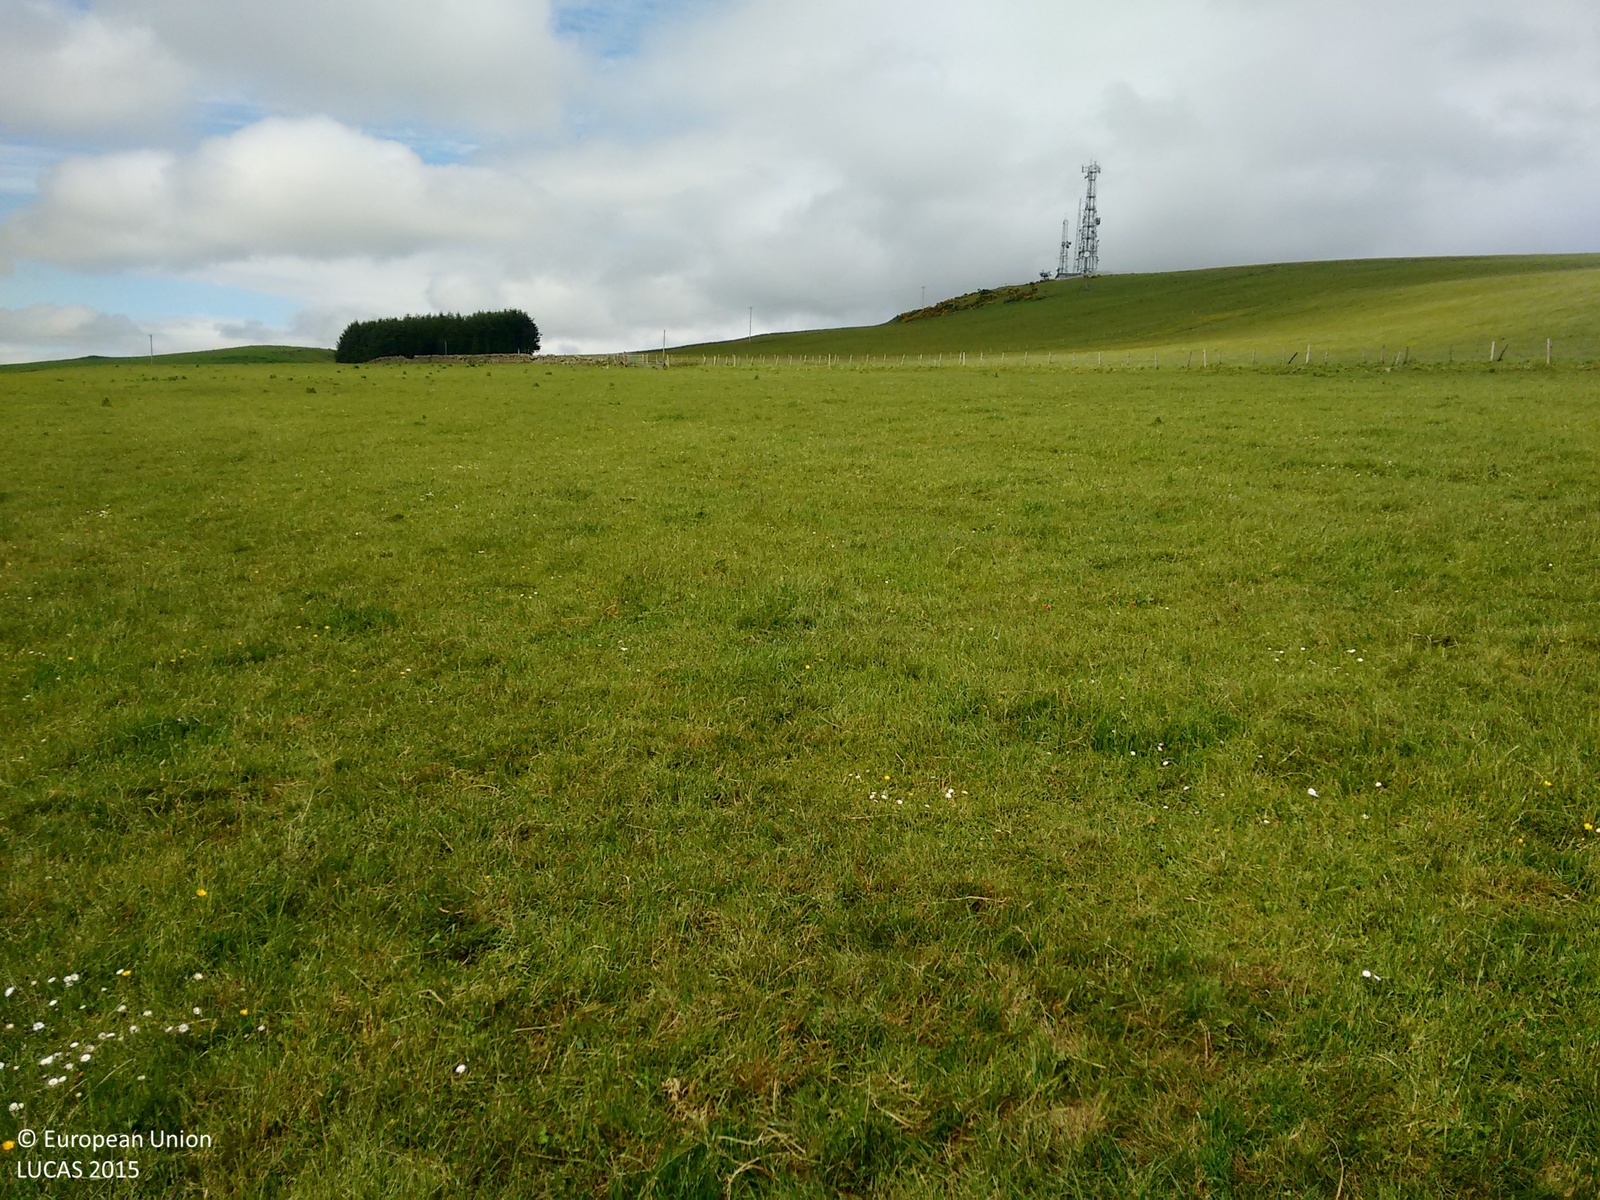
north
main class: Grassland
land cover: Grassland without tree/shrub cover
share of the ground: > 75 %
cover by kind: herbaceous plants 100 %
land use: Agriculture (excluding fallow land and kitchen gardens)
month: June
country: GB
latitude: 55.0716
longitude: -3.4699
